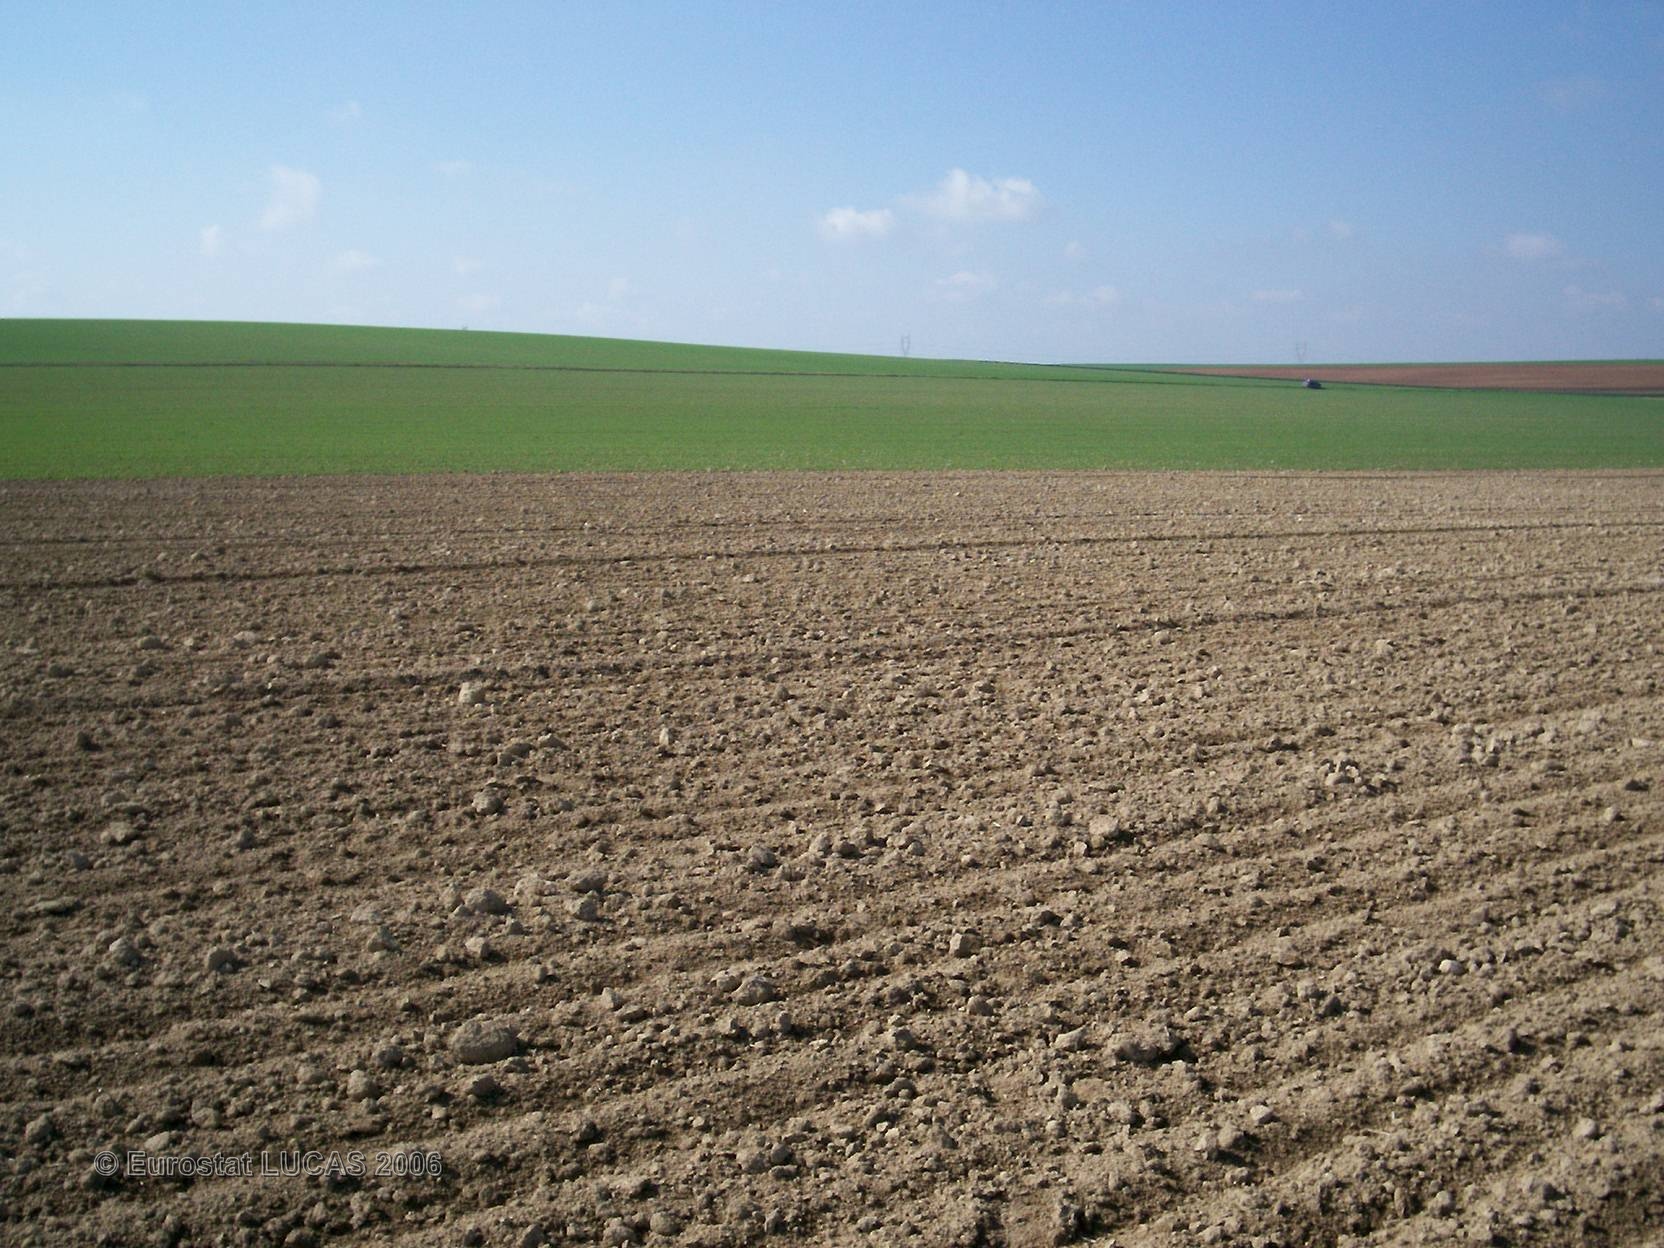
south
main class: Cropland
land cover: Other fibre and oleaginous crops
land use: Agriculture (excluding fallow land and kitchen gardens)
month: May
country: FR
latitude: 48.5377
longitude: 4.5120
